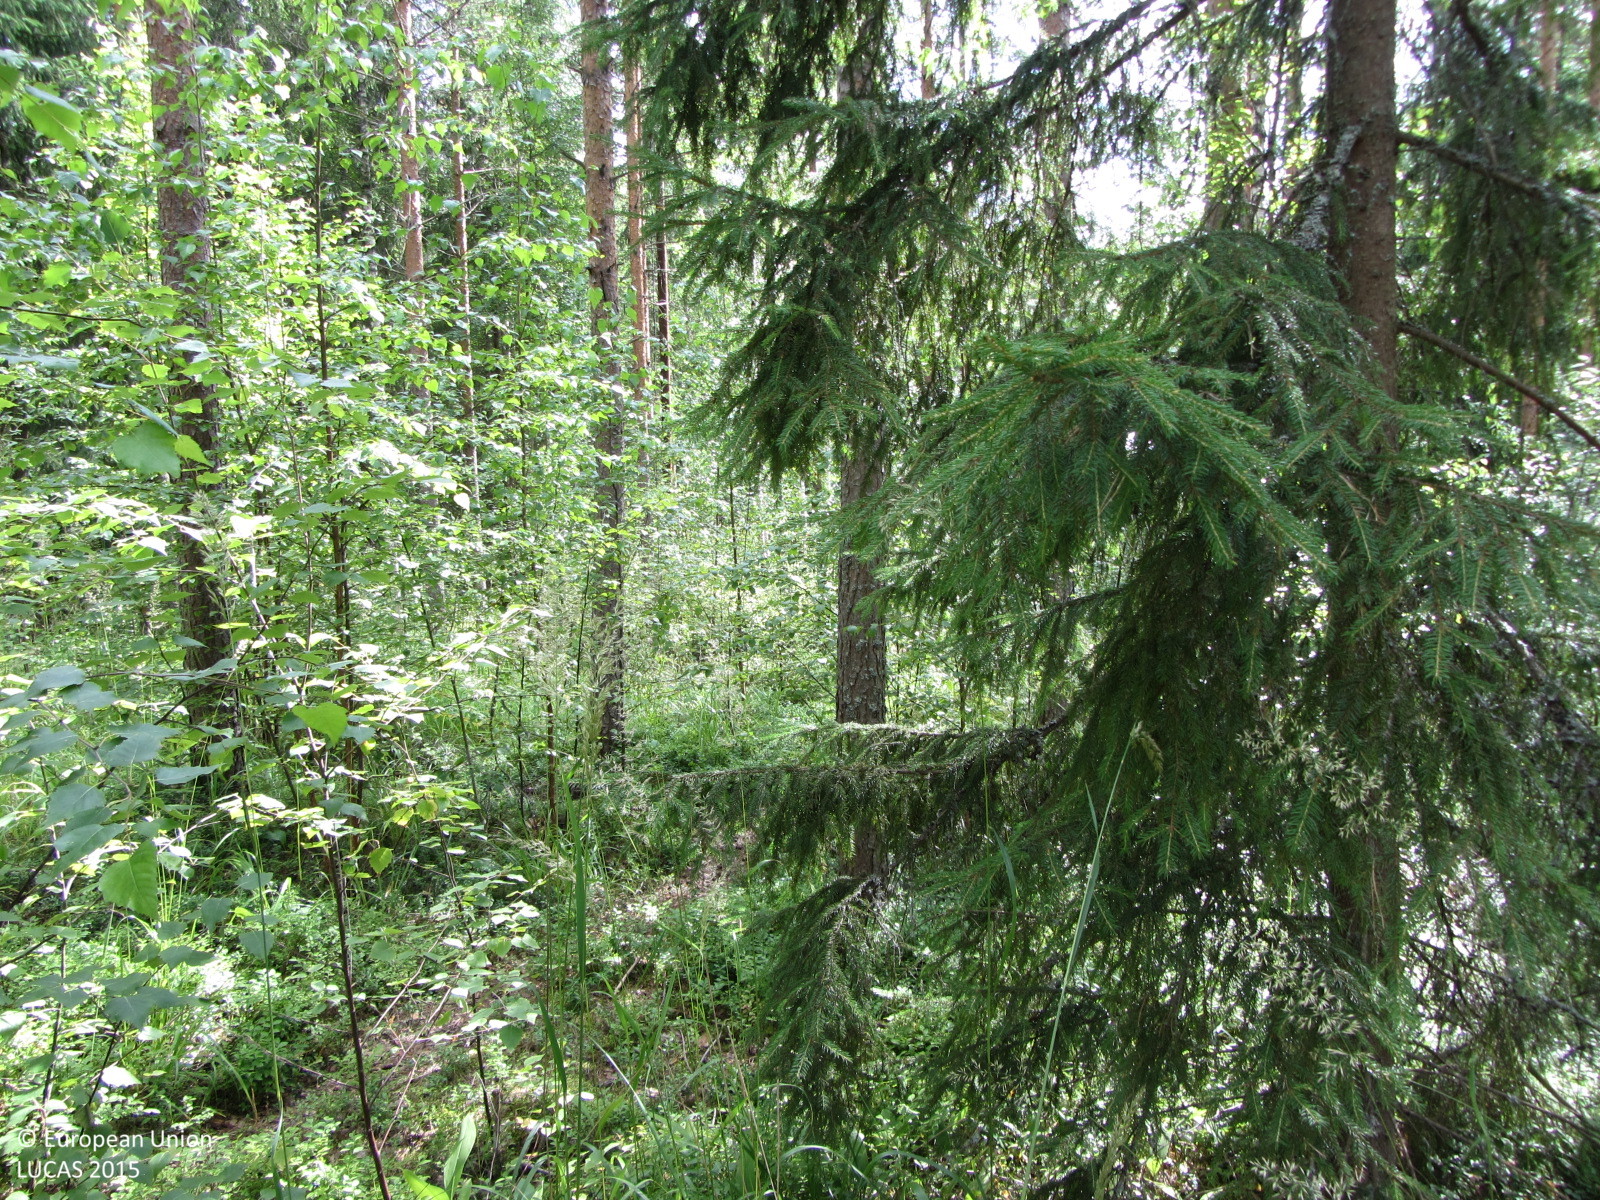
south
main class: Woodland
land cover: Pine dominated mixed woodland
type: boreal forest
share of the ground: > 75 %
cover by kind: coniferous forest trees 60 %, broadleaved forest trees 20 %, shrubs 10 %, herbaceous plants 10 %
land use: Forestry
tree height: > 5 m
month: July
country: FI
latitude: 60.6868
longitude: 24.5534
